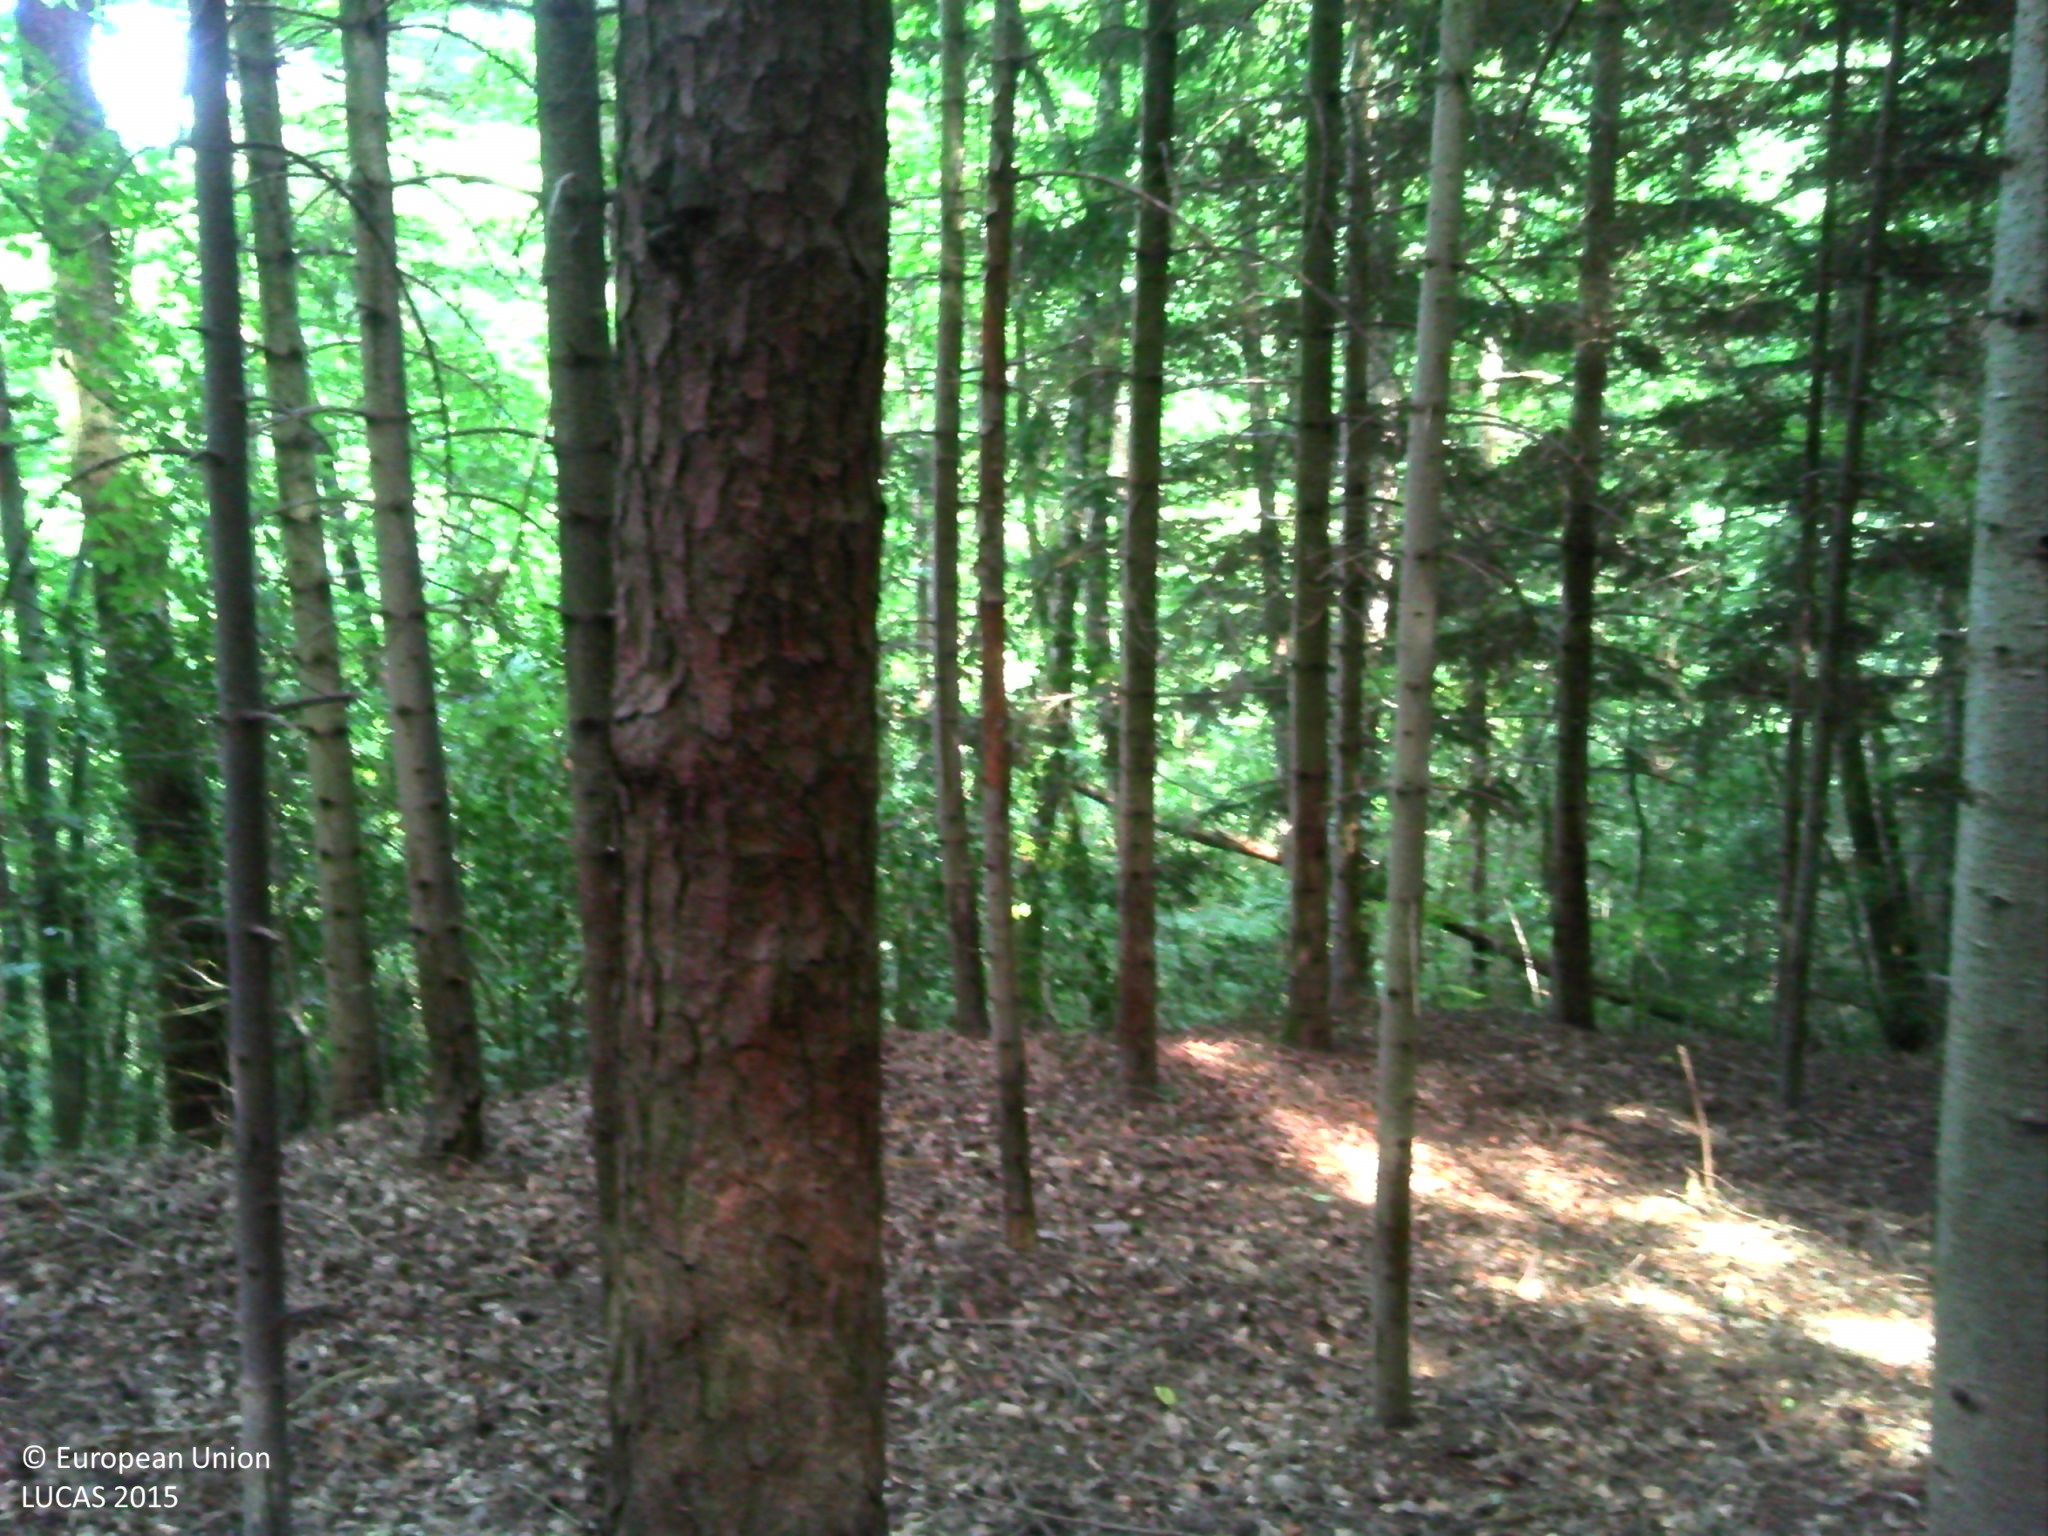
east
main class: Woodland
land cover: Spruce dominated coniferous woodland
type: hemiboreal forest and nemoral coniferous forest and mixed broadleaved-coniferous forest
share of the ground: > 75 %
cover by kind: coniferous forest trees 95 %, unconsolidated bare surface 5 %
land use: Forestry
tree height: > 5 m
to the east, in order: Spruce dominated coniferous woodland; Pine dominated mixed woodland; Spruce dominated coniferous woodland; Ditches and canals; Tracks; Pine dominated mixed woodland; Grass margins; Tracks; Grass margins; Other coniferous woodland; Tracks; Broadleaved woodland; Tracks; Broadleaved woodland; Fences; Grassland without tree/shrub cover; Abandoned hedges; Rivers and streams; Abandoned hedges; Grassland without tree/shrub cover; Single bushes/trees; Grassland without tree/shrub cover; Fences; Broadleaved woodland
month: July
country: FR
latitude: 45.1712
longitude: 3.1183
